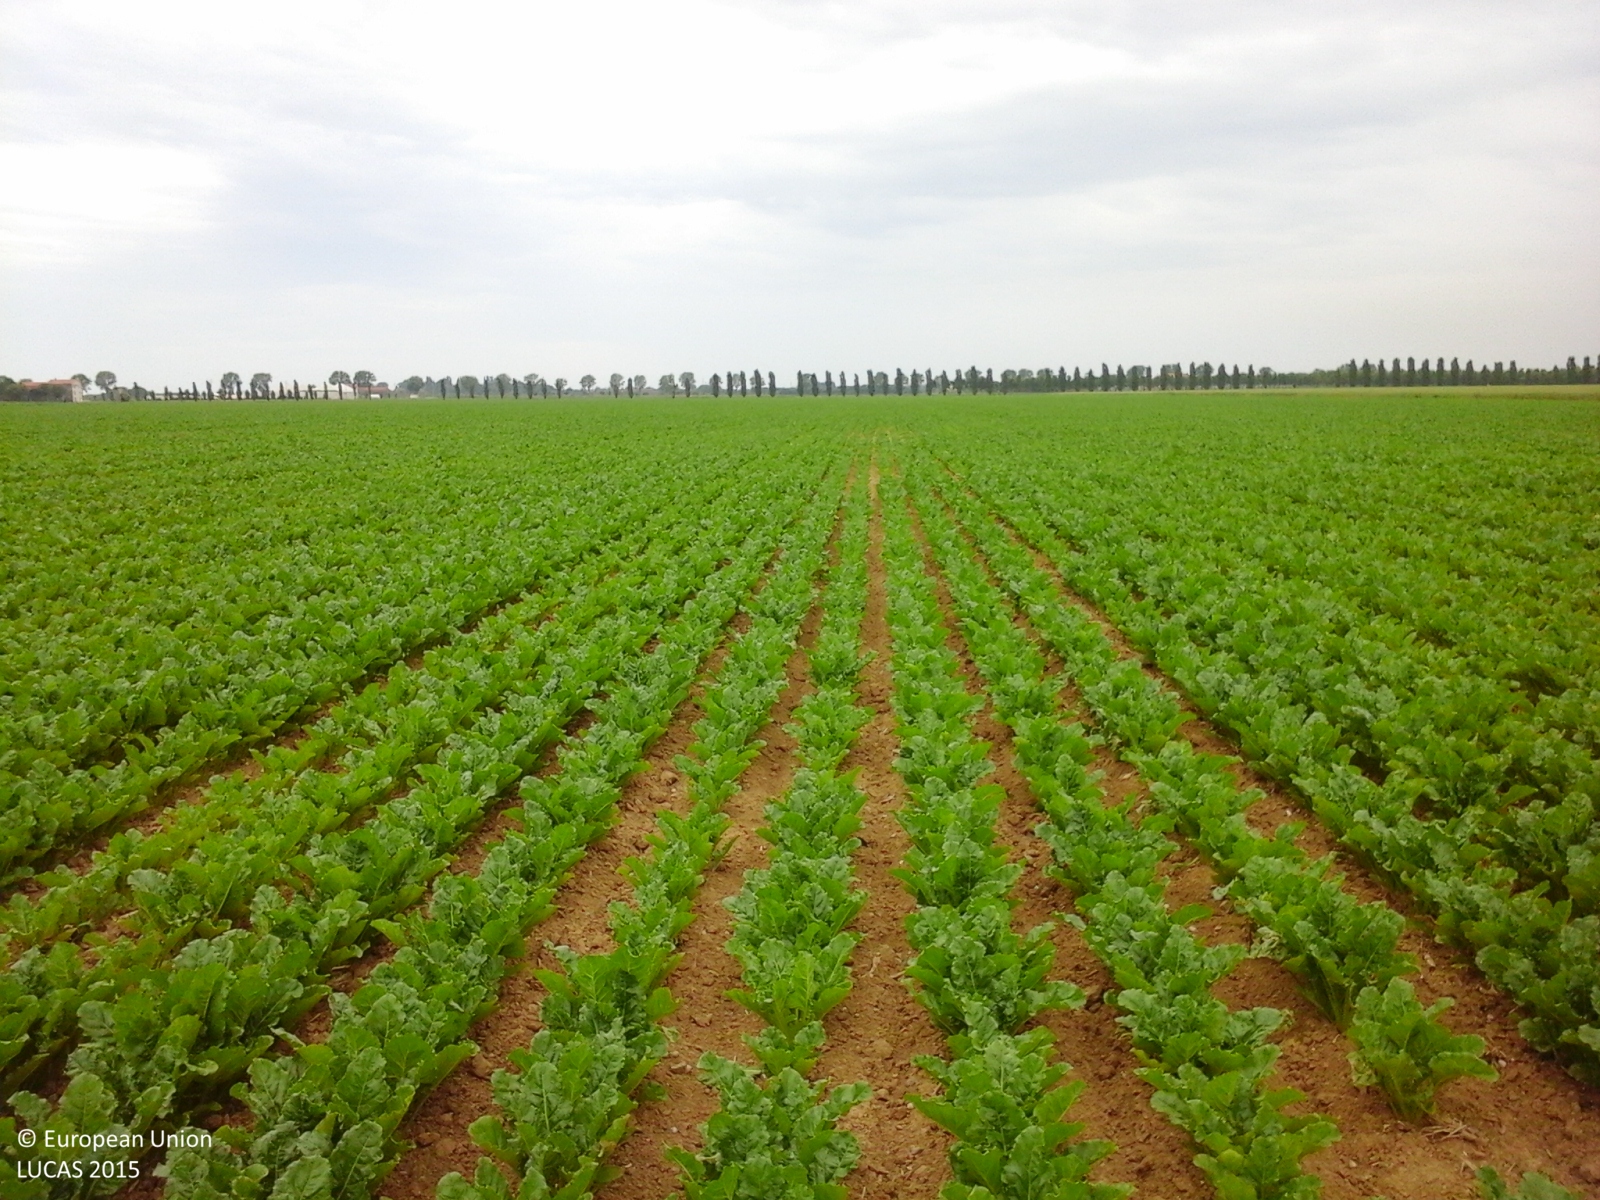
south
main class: Cropland
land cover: Sugar beet
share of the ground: 50 - 75 %
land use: Agriculture (excluding fallow land and kitchen gardens)
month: May
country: IT
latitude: 45.5500
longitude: 12.3661
